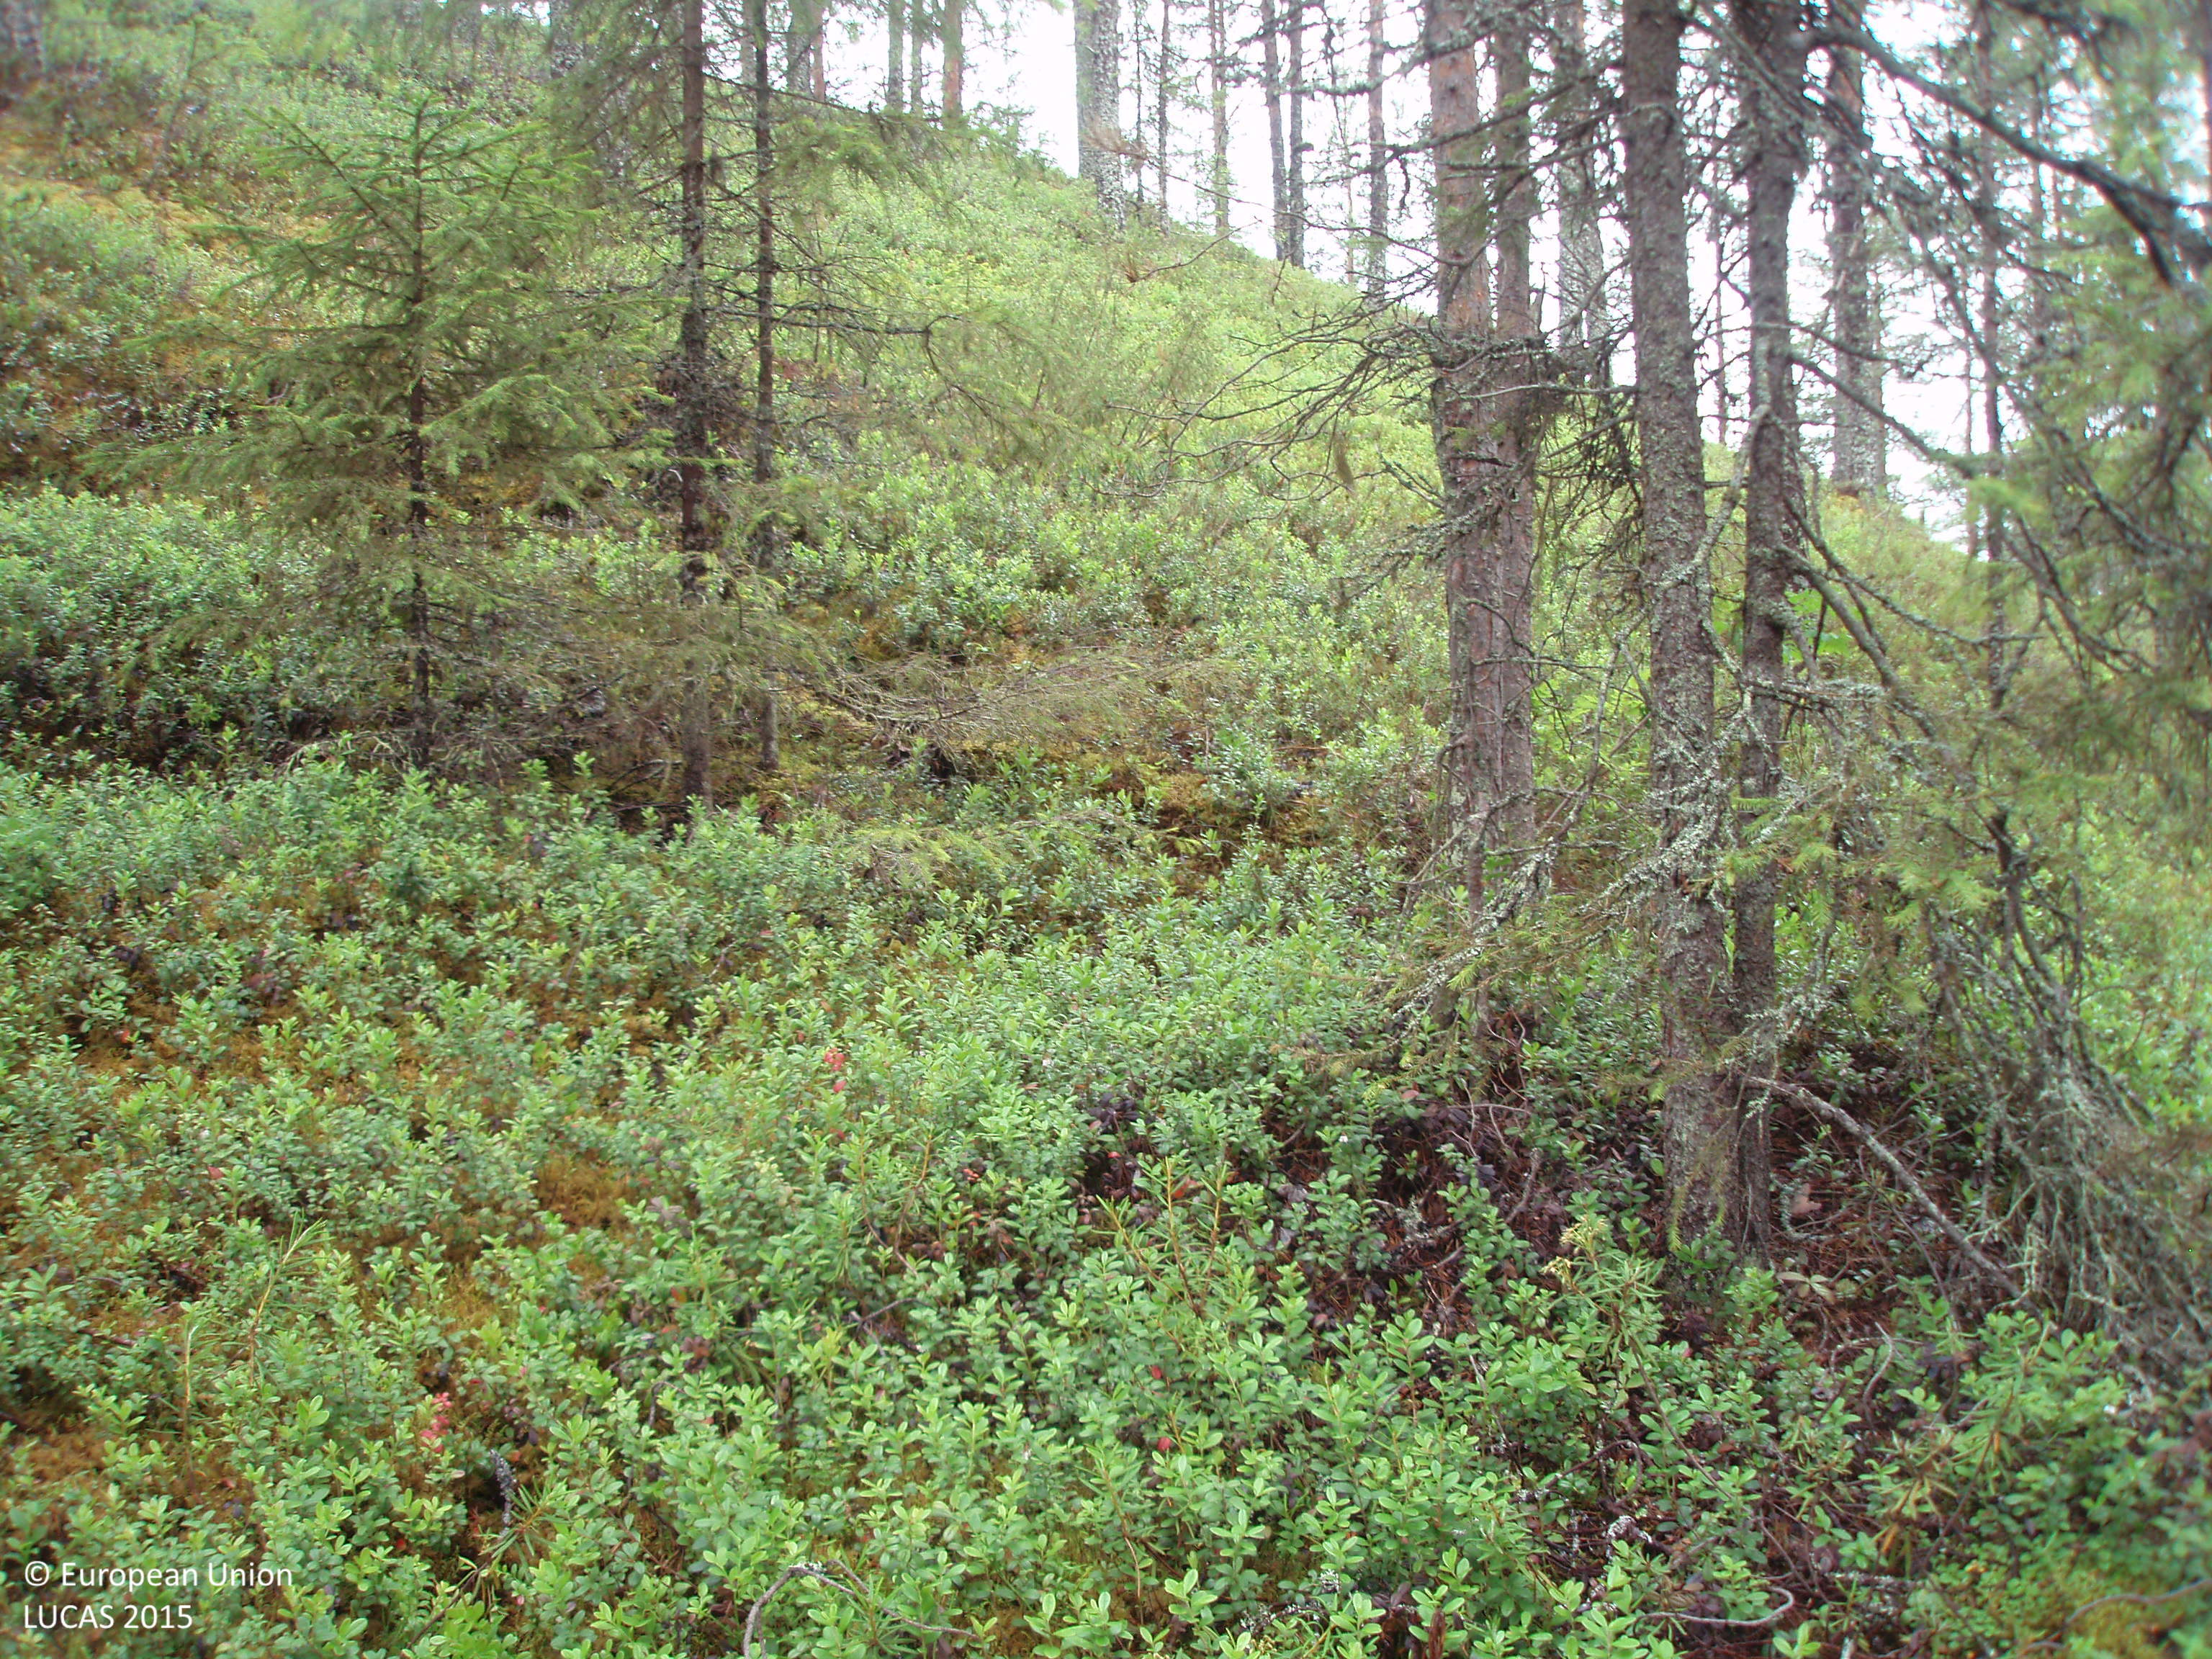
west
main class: Woodland
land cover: Pine dominated coniferous woodland
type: boreal forest
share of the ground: 50 - 75 %
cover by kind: coniferous forest trees 70 %, shrubs 30 %
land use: Forestry
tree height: > 5 m
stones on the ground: 10 - 25 %
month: July
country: FI
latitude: 67.2351
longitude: 28.4020
